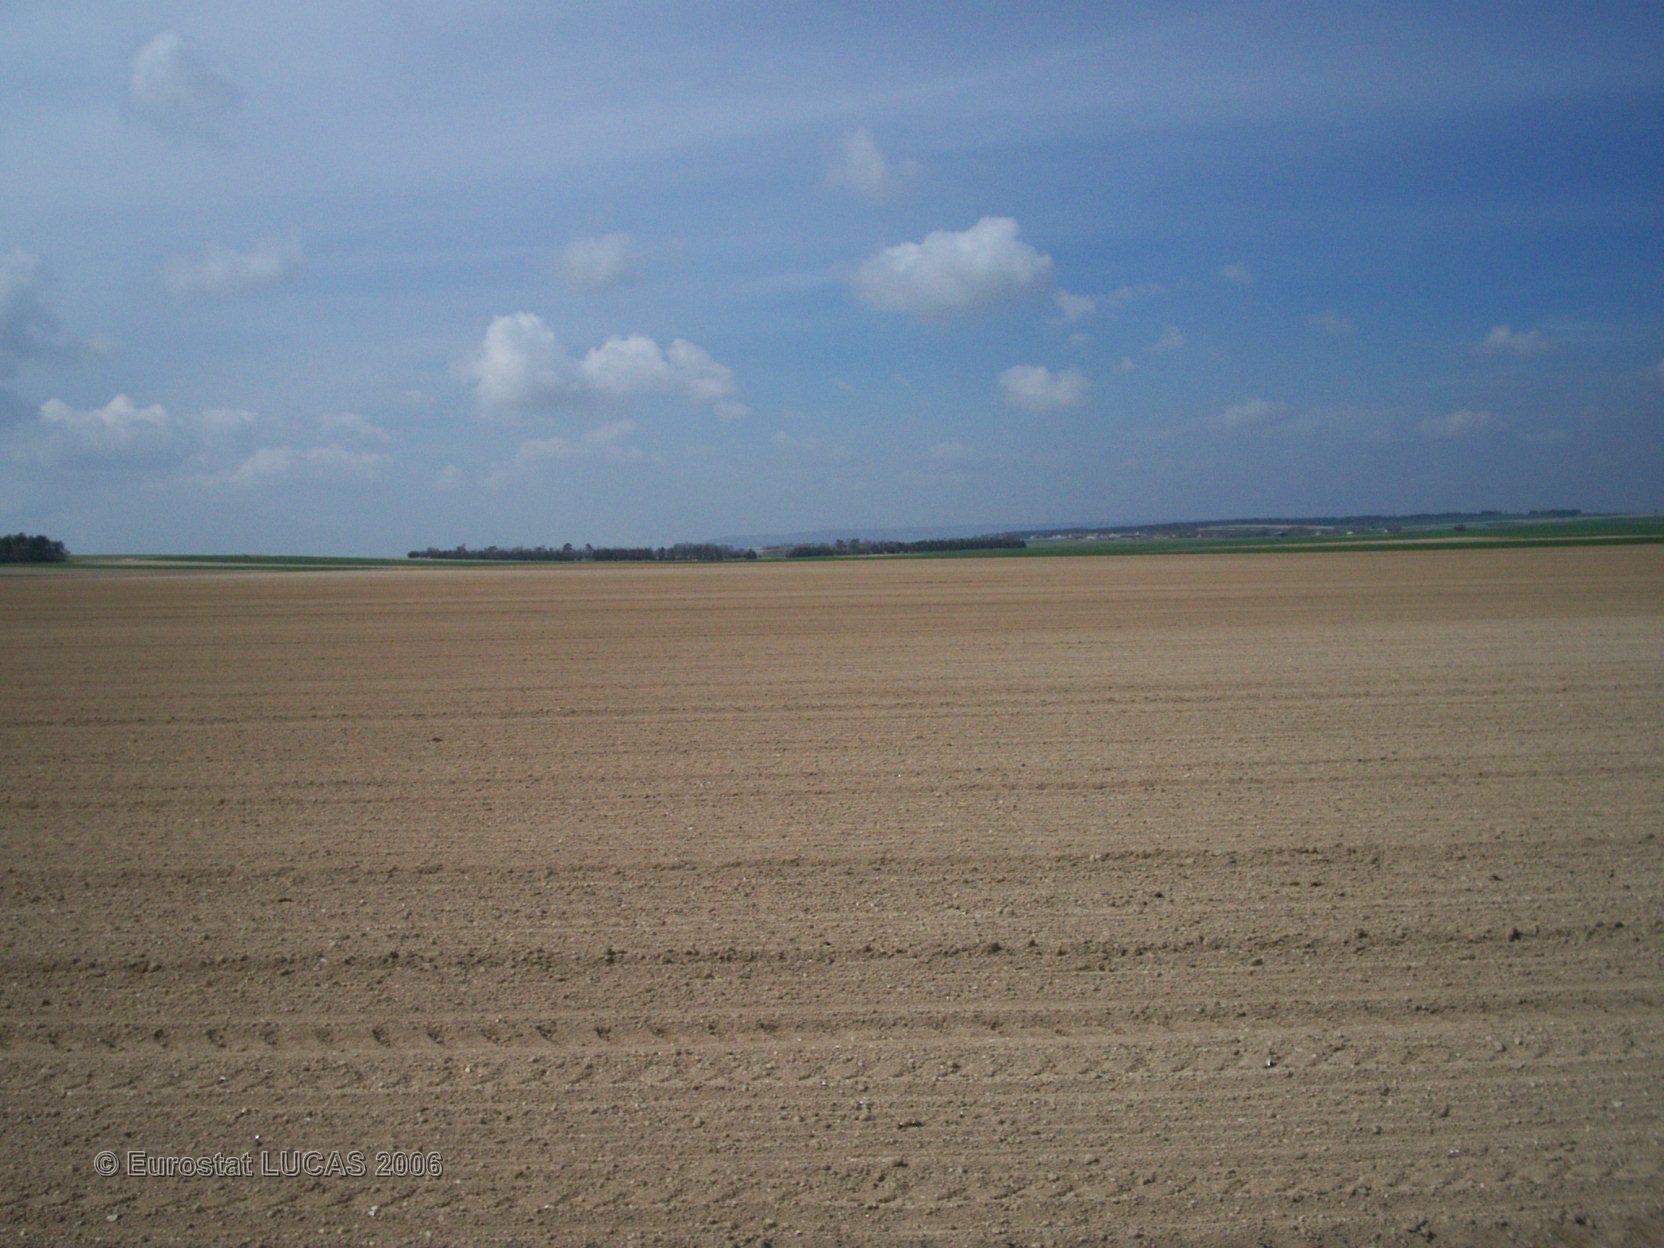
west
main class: Cropland
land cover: Sugar beet
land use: Agriculture (excluding fallow land and kitchen gardens)
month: June
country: FR
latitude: 49.1626
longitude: 4.3873
